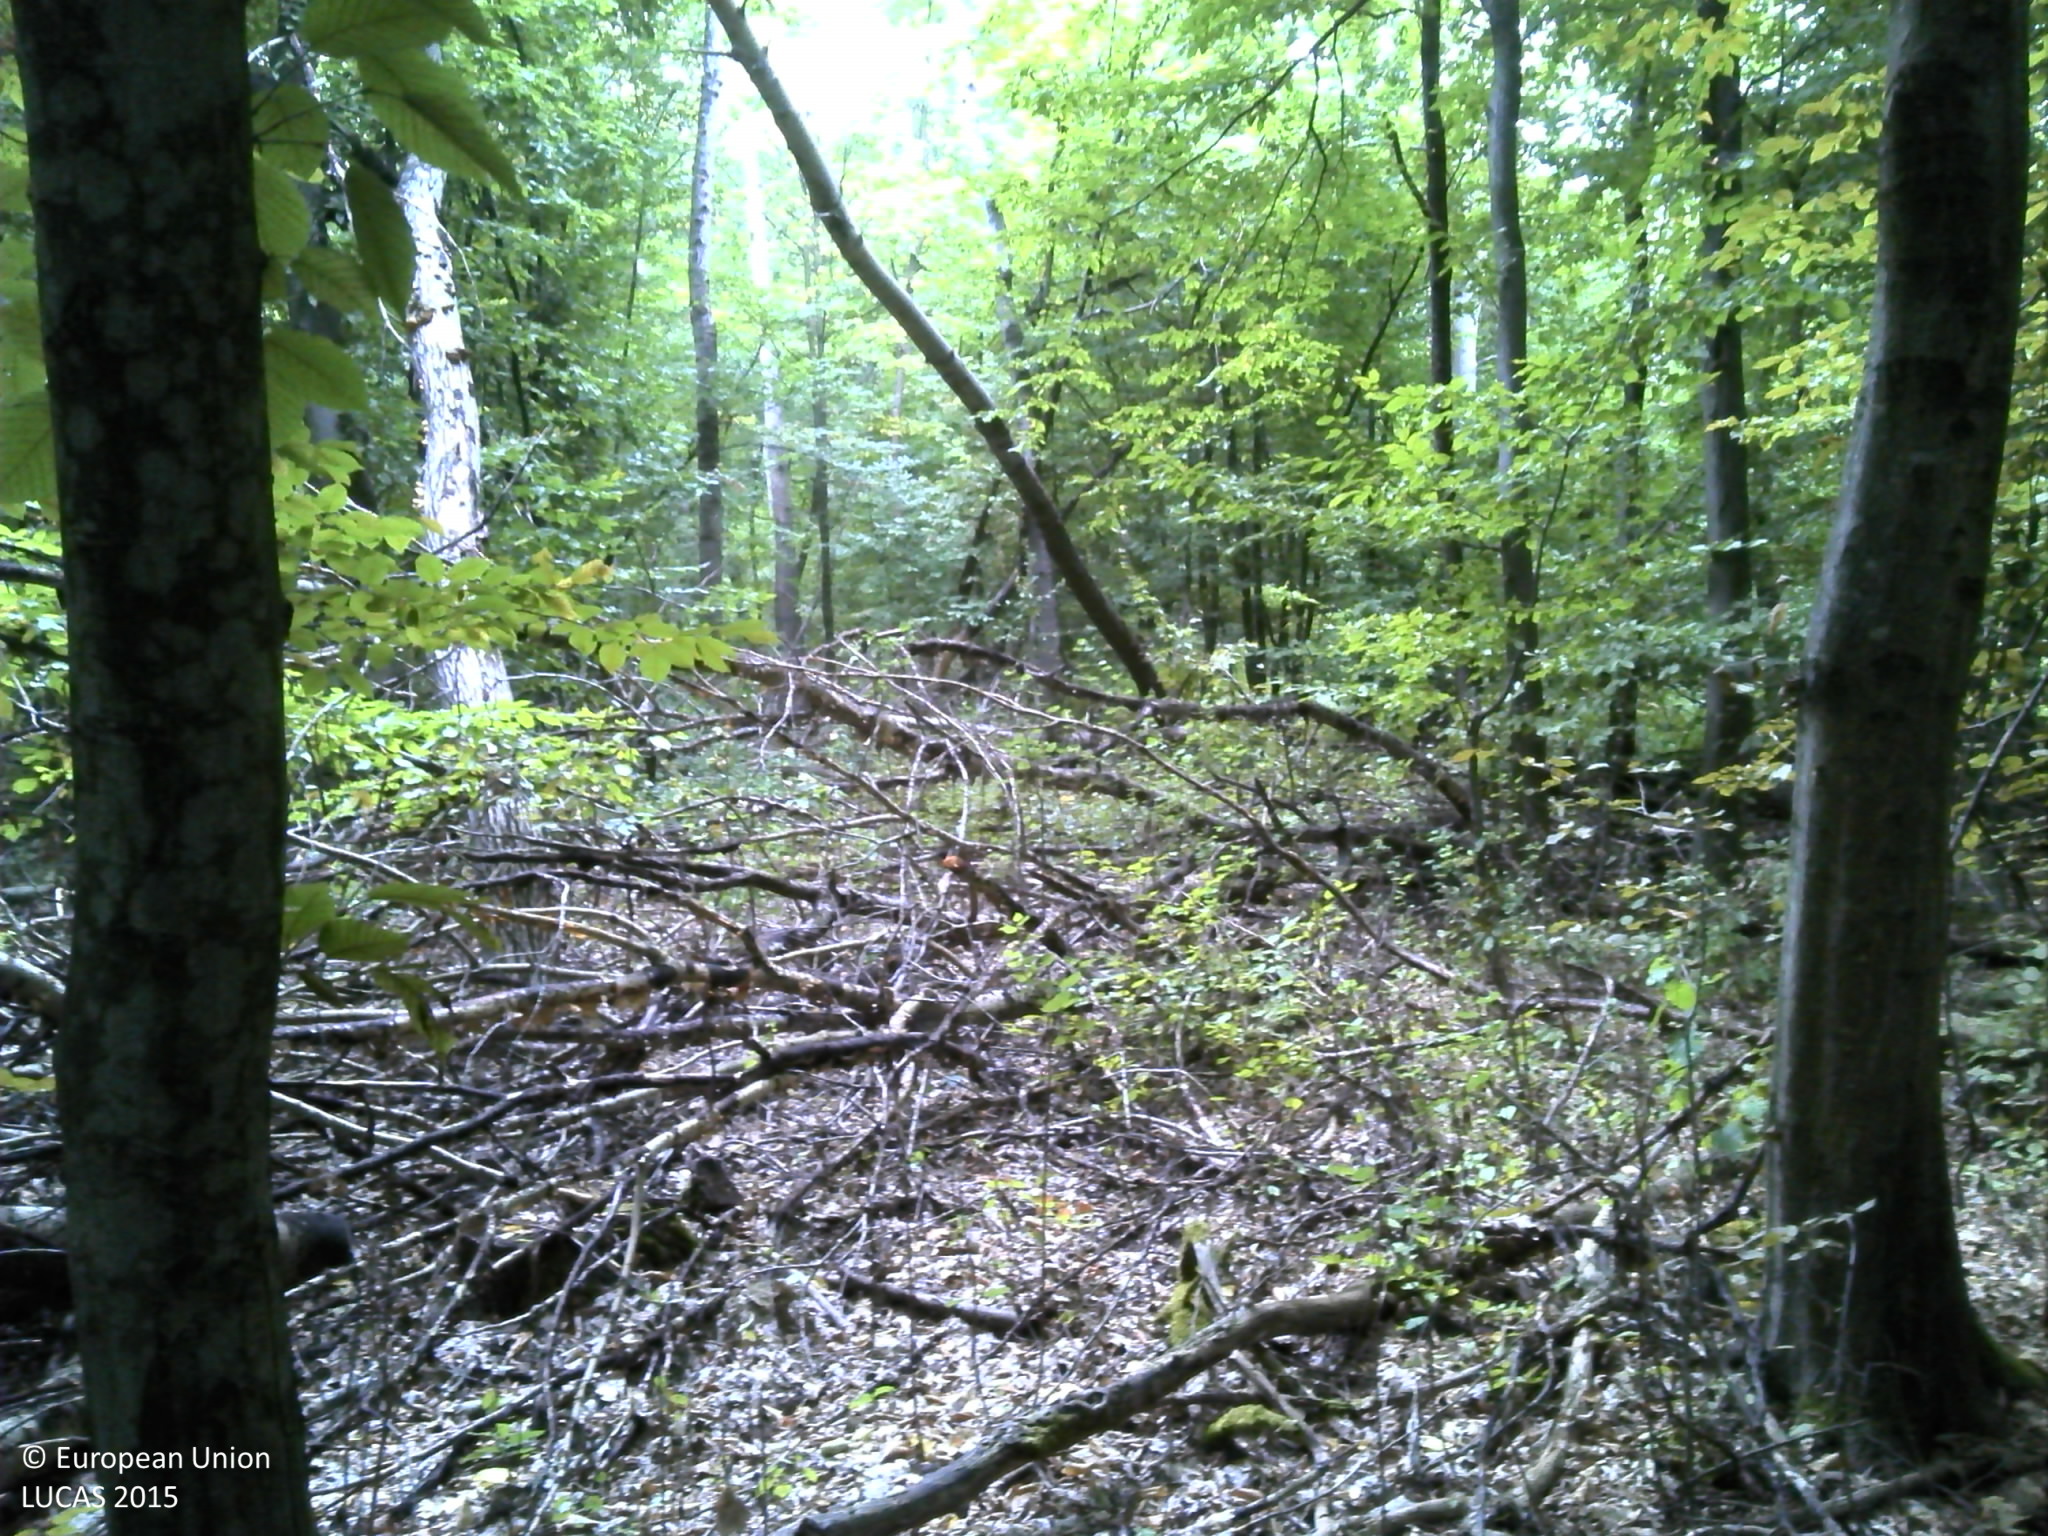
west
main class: Woodland
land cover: Broadleaved woodland
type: acidophilous oak and oak-birch forest
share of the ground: > 75 %
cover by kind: broadleaved forest trees 100 %
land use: Forestry
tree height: > 5 m
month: August
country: HR
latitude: 45.4920
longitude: 17.9754
